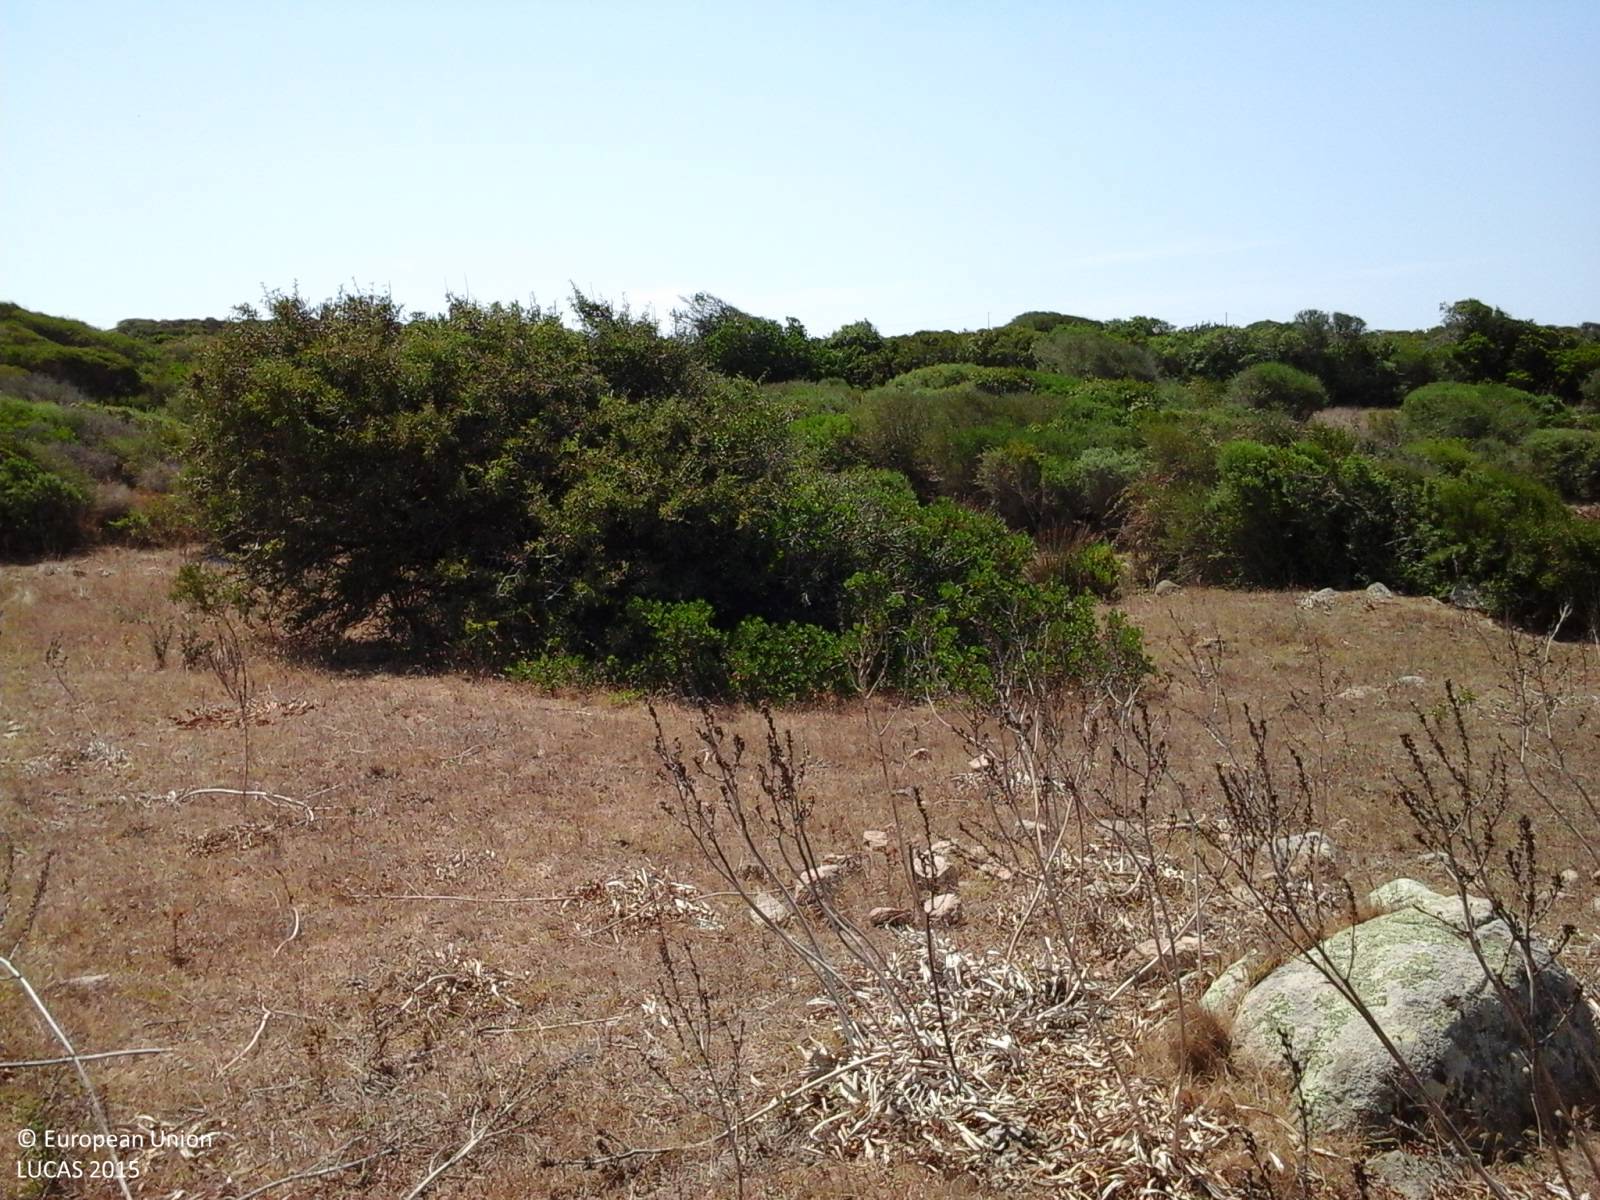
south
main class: Grassland
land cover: Grassland without tree/shrub cover
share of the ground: 25 - 50 %
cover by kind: herbaceous plants 100 %
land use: Agriculture (excluding fallow land and kitchen gardens)
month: July
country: IT
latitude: 41.2231
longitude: 9.2043
